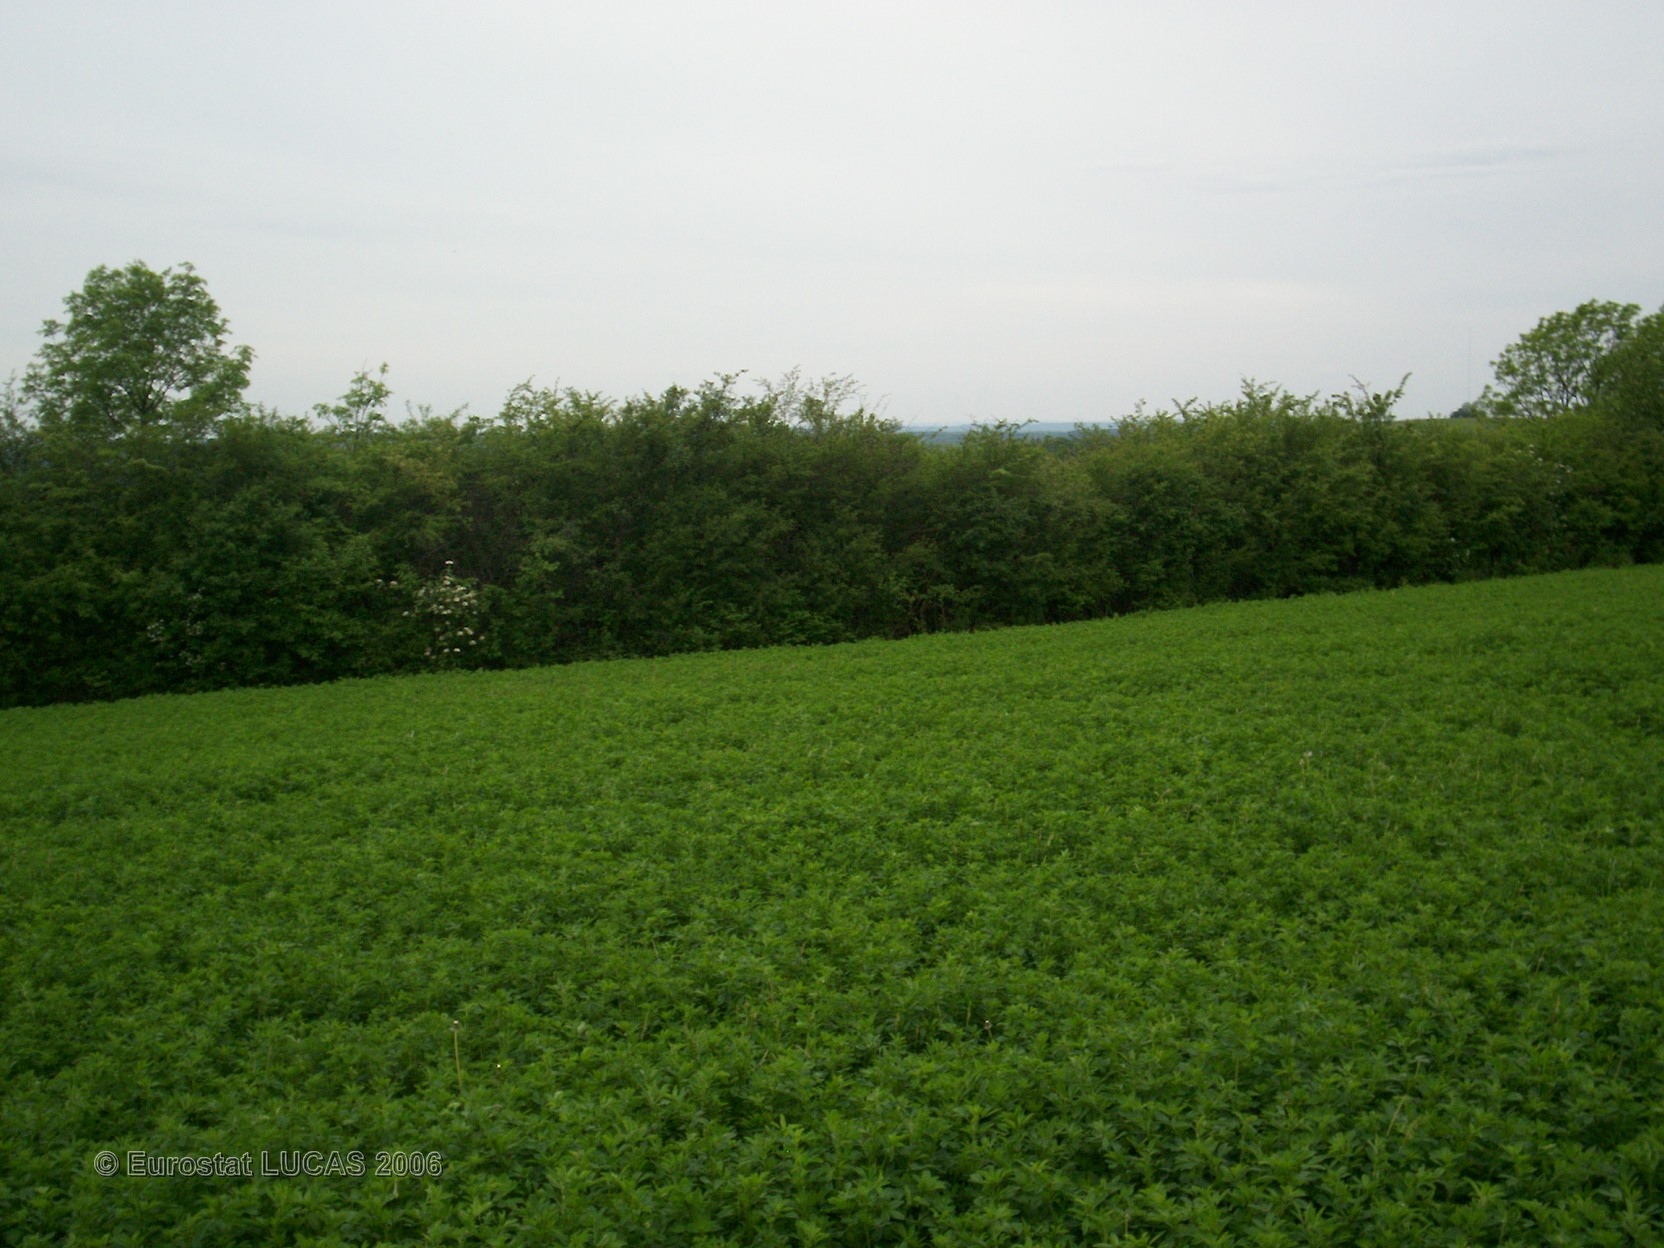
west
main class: Cropland
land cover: Lucerne
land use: Agriculture (excluding fallow land and kitchen gardens)
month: May
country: FR
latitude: 47.3190
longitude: 4.6682
